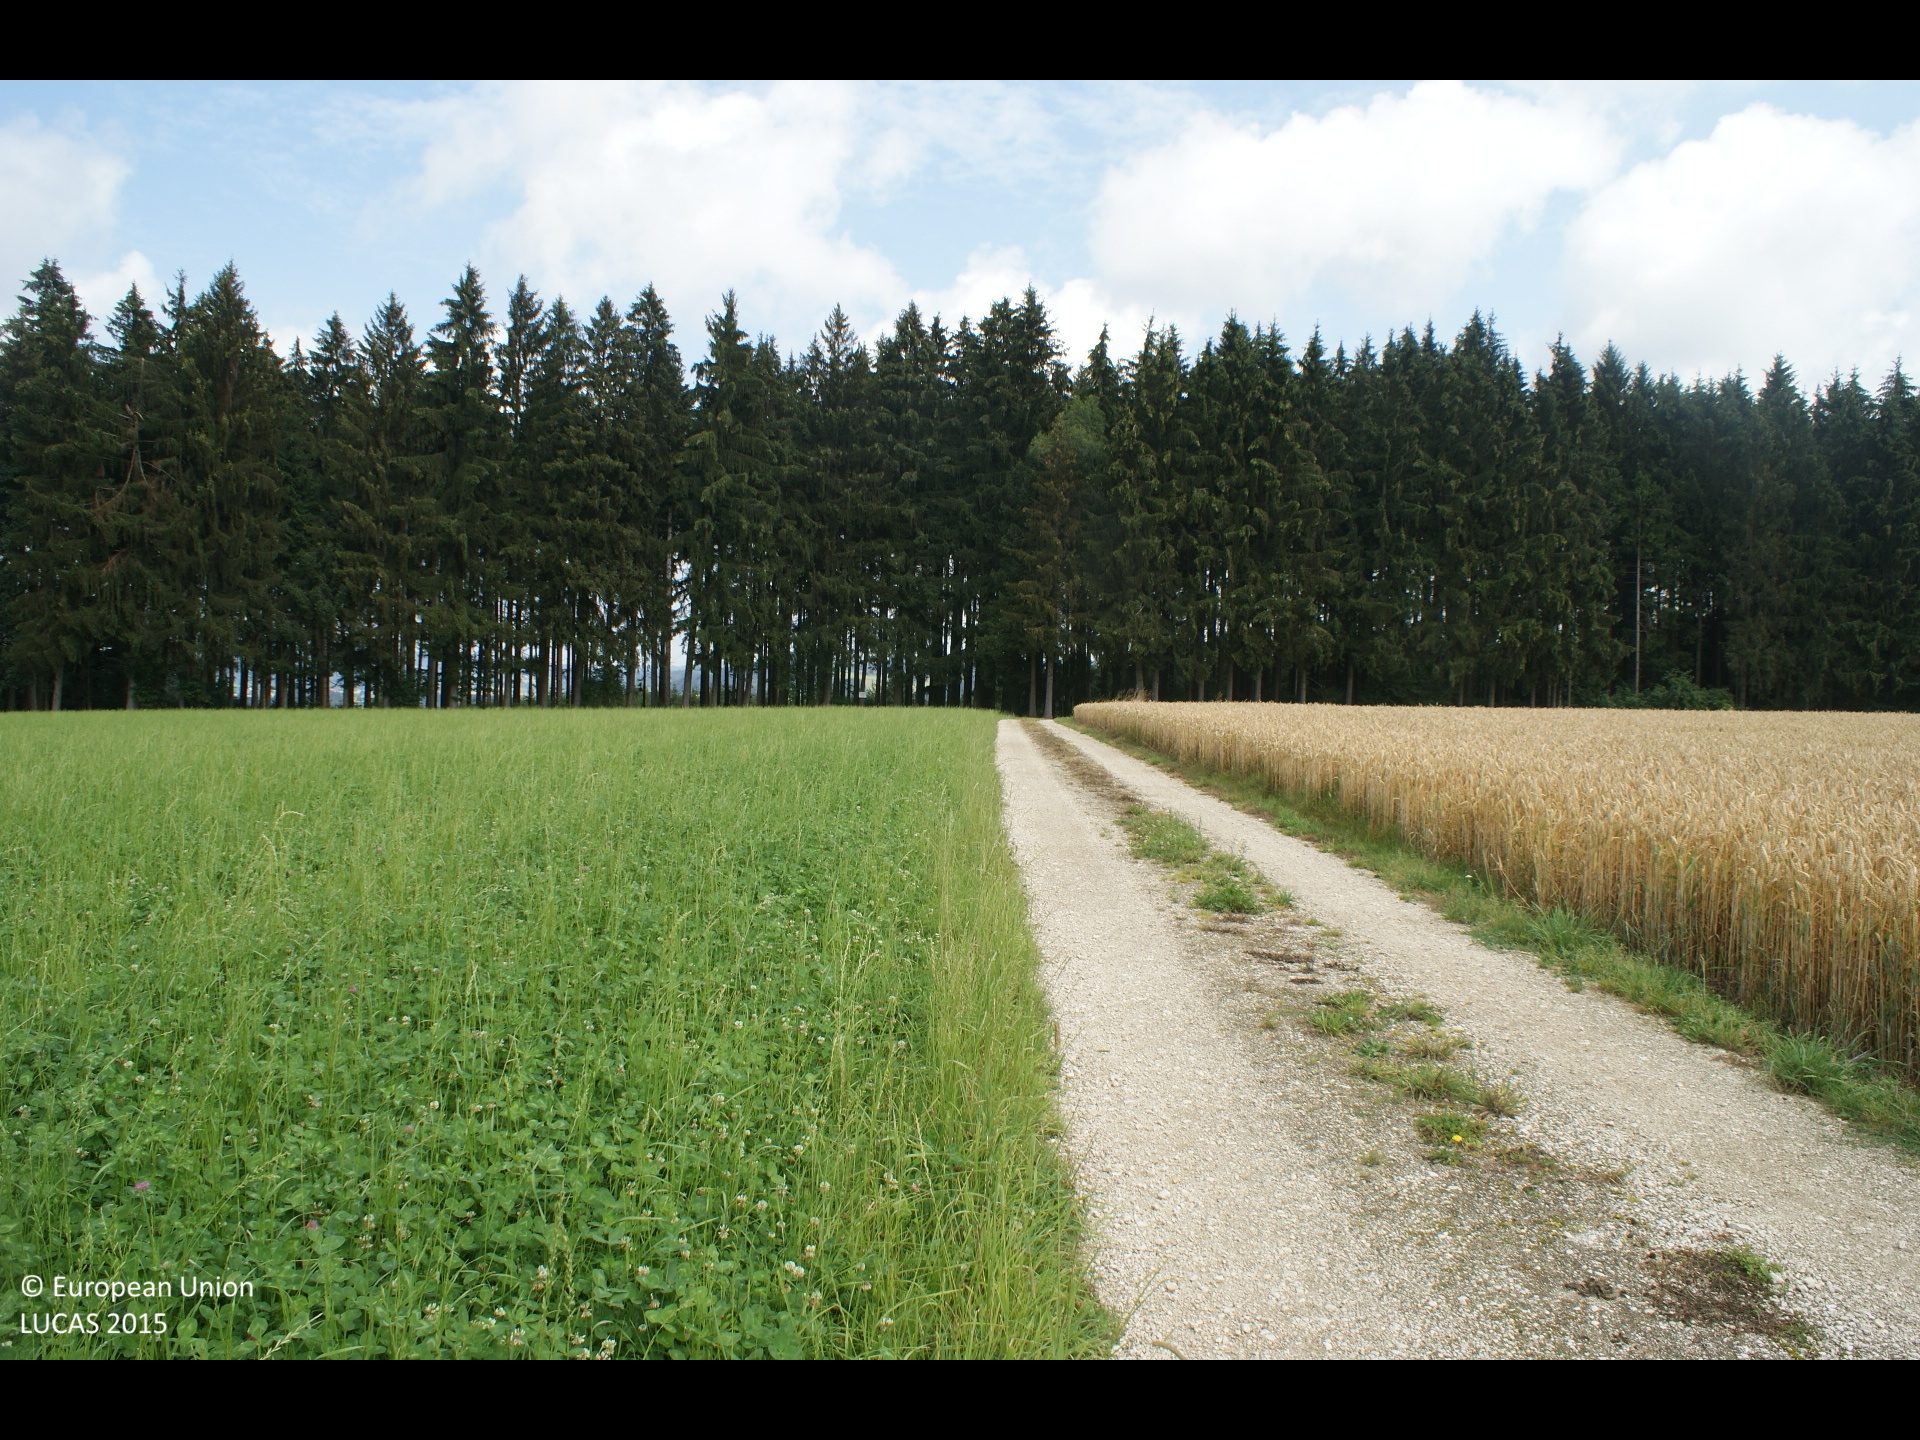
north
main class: Cropland
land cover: Temporary grasslands
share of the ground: > 75 %
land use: Agriculture (excluding fallow land and kitchen gardens)
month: July
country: AT
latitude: 48.0034
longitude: 13.5778
